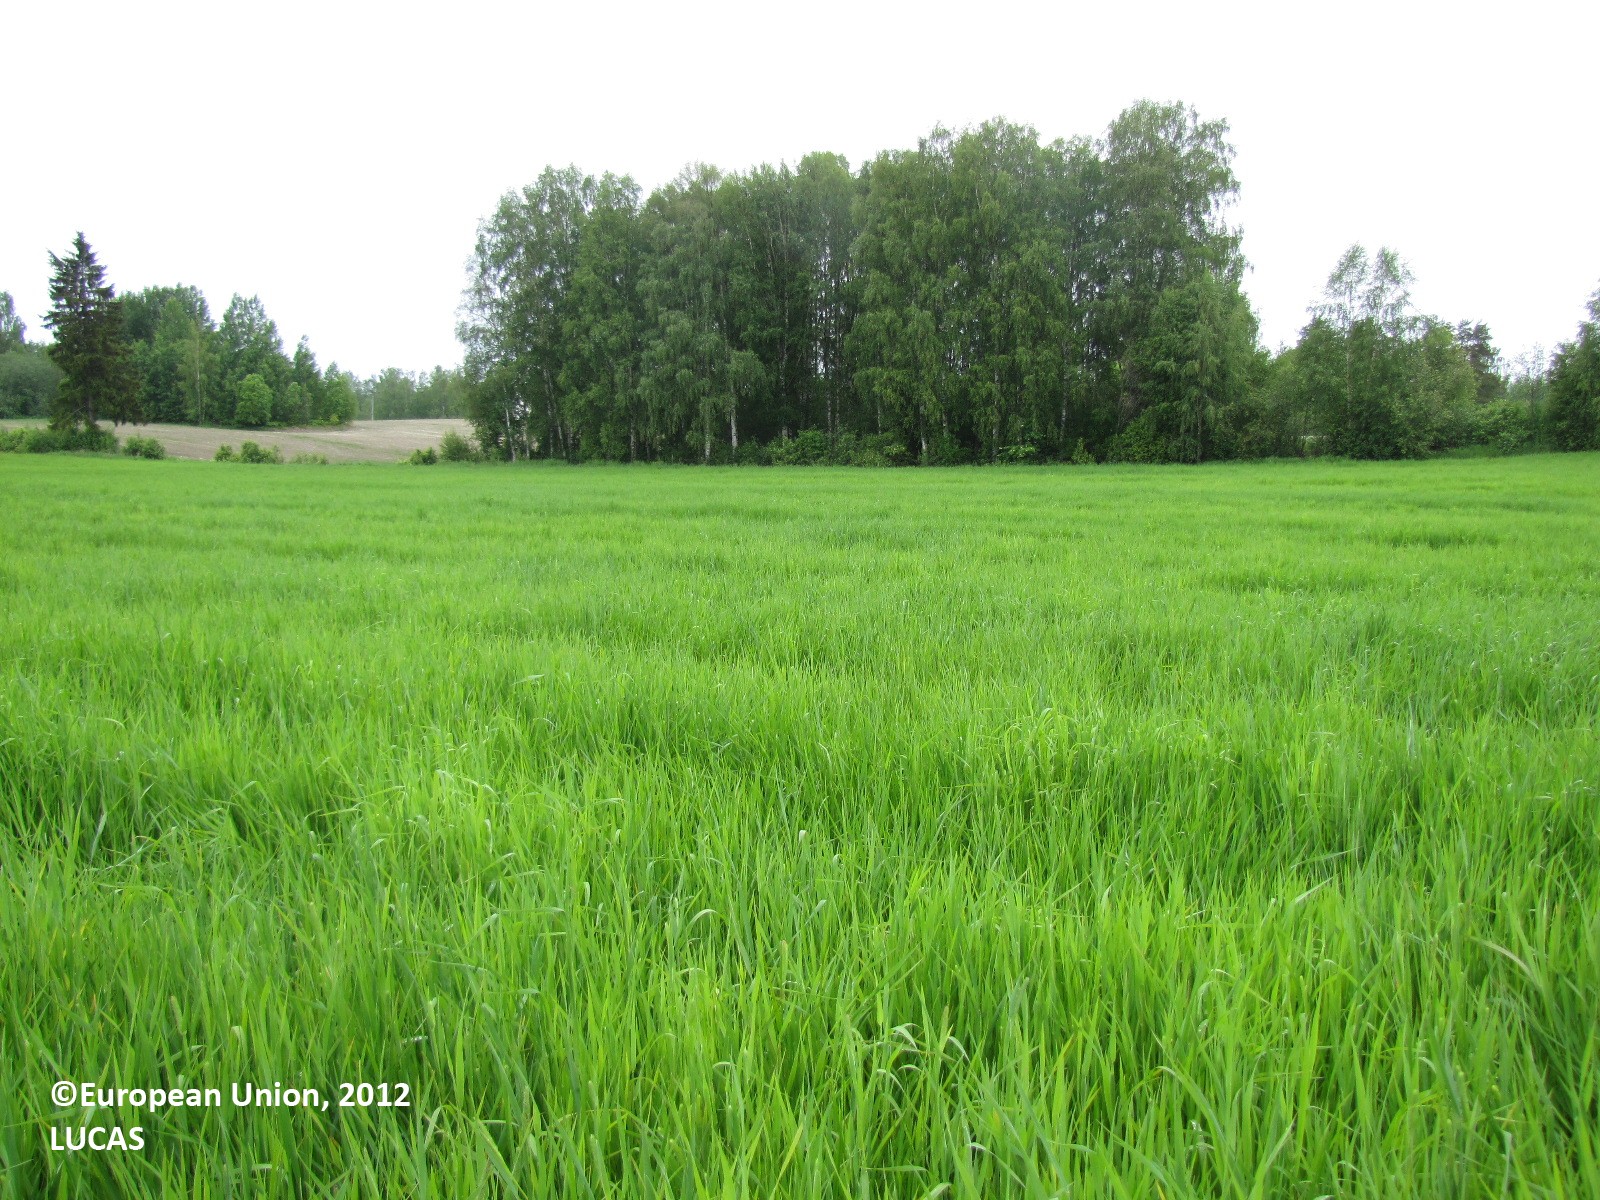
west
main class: Cropland
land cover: Temporary grasslands
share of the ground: > 75 %
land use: Agriculture (excluding fallow land and kitchen gardens)
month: June
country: FI
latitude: 61.4814
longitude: 24.6913
